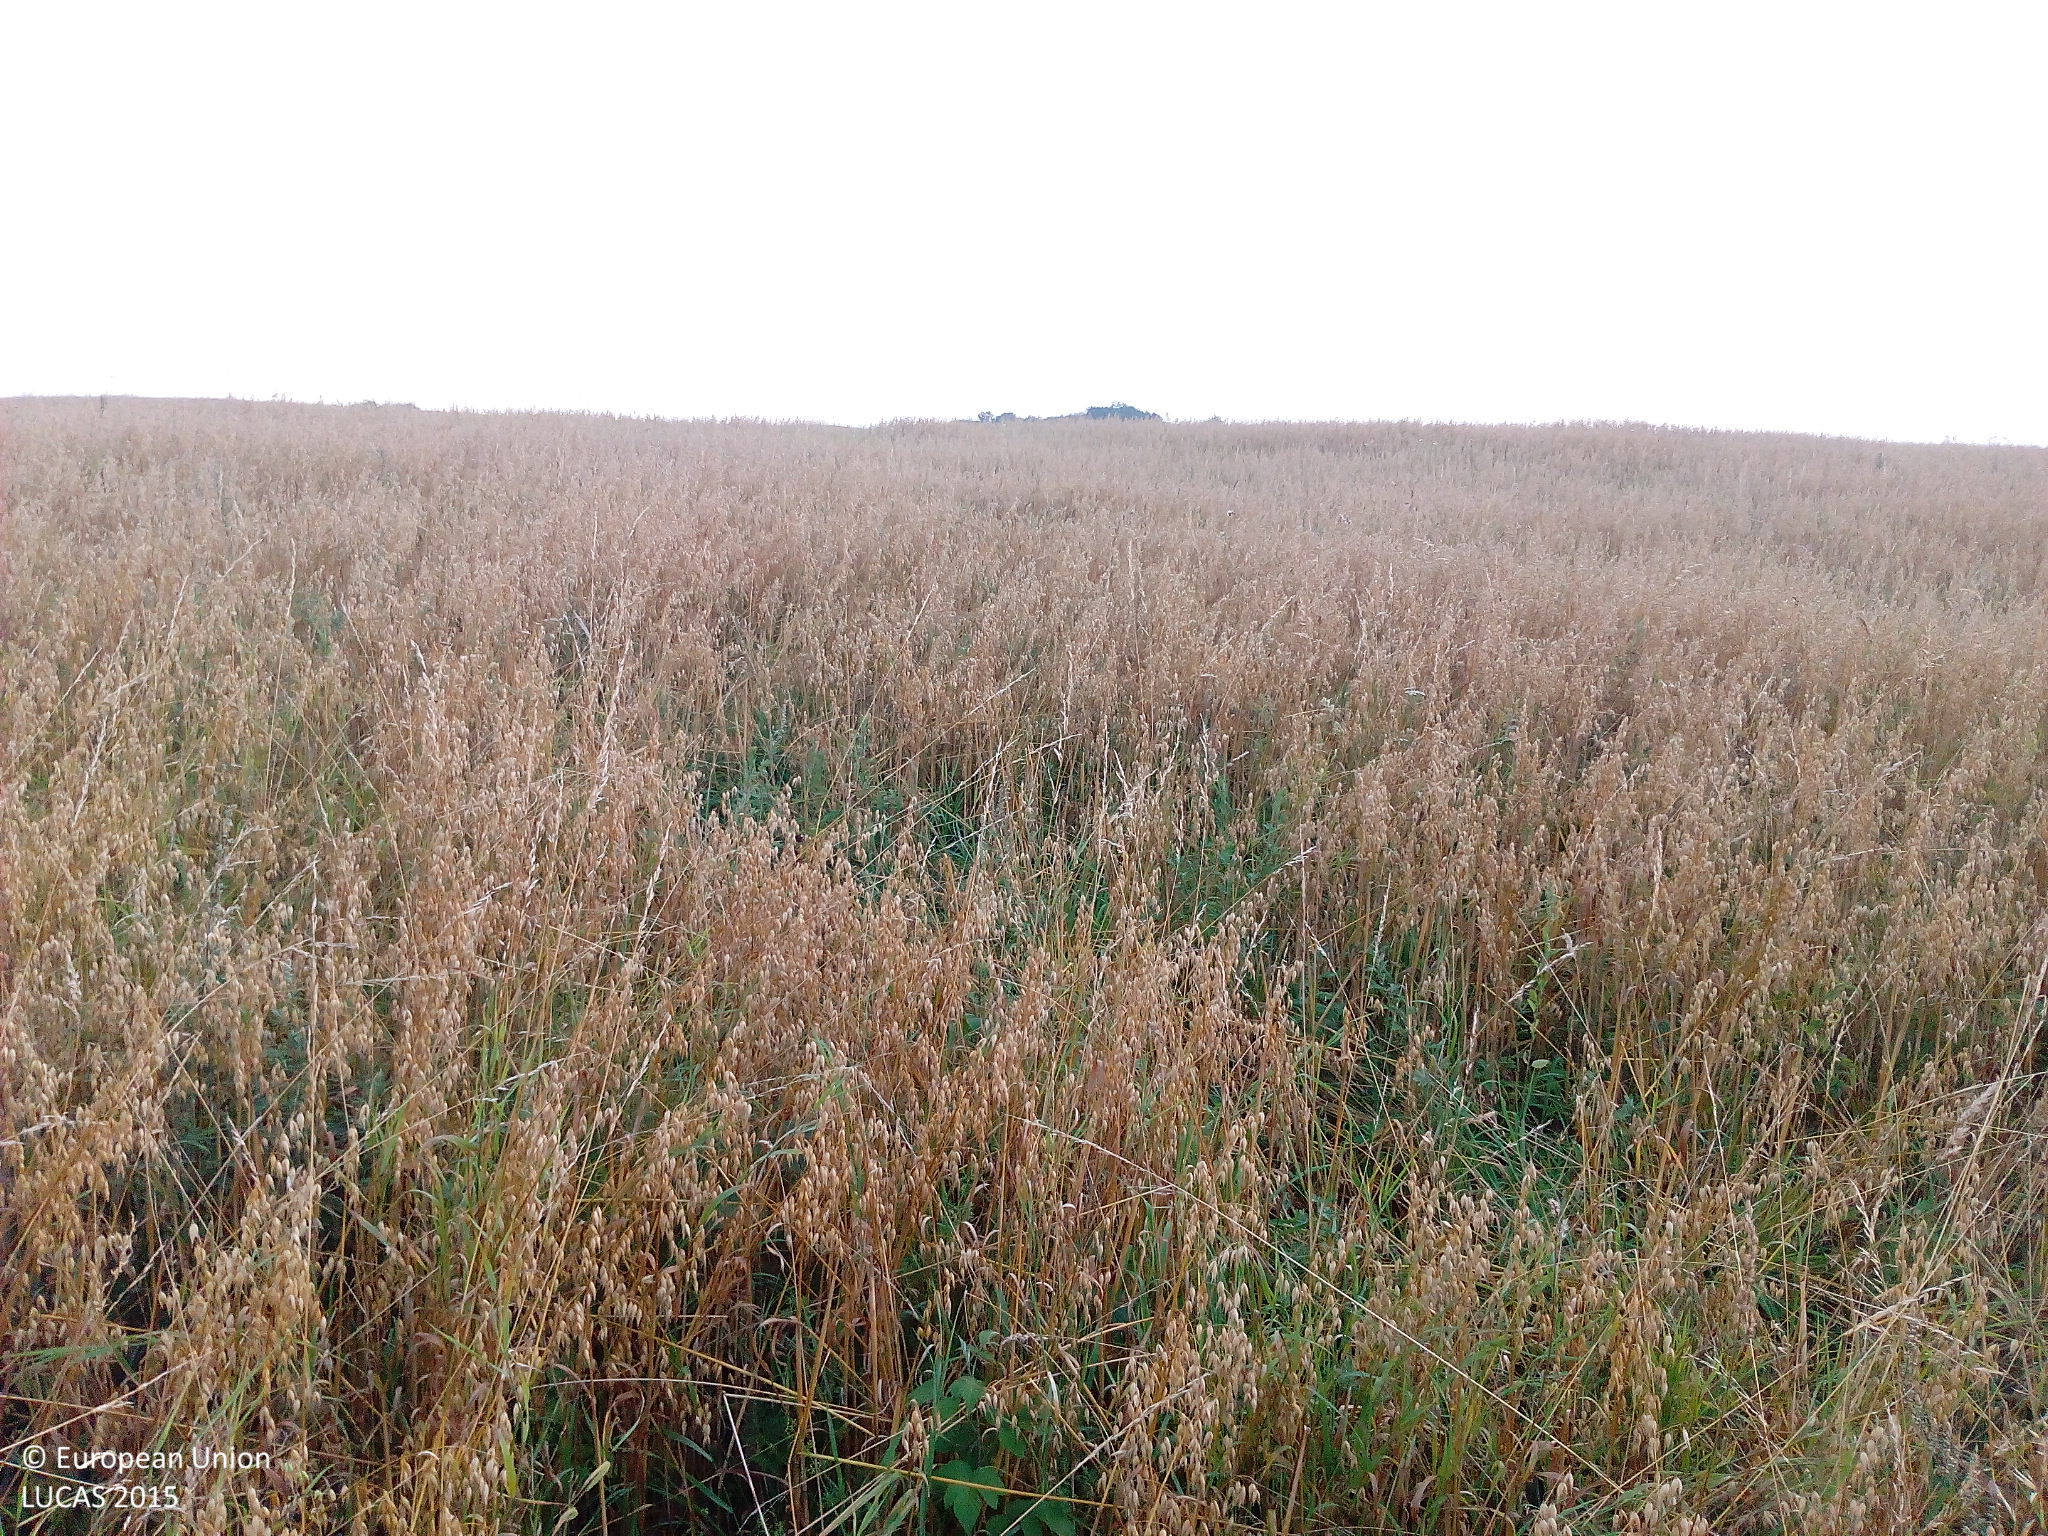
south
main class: Cropland
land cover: Oats
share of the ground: > 75 %
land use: Agriculture (excluding fallow land and kitchen gardens)
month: August
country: DE
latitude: 53.7214
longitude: 12.3178
